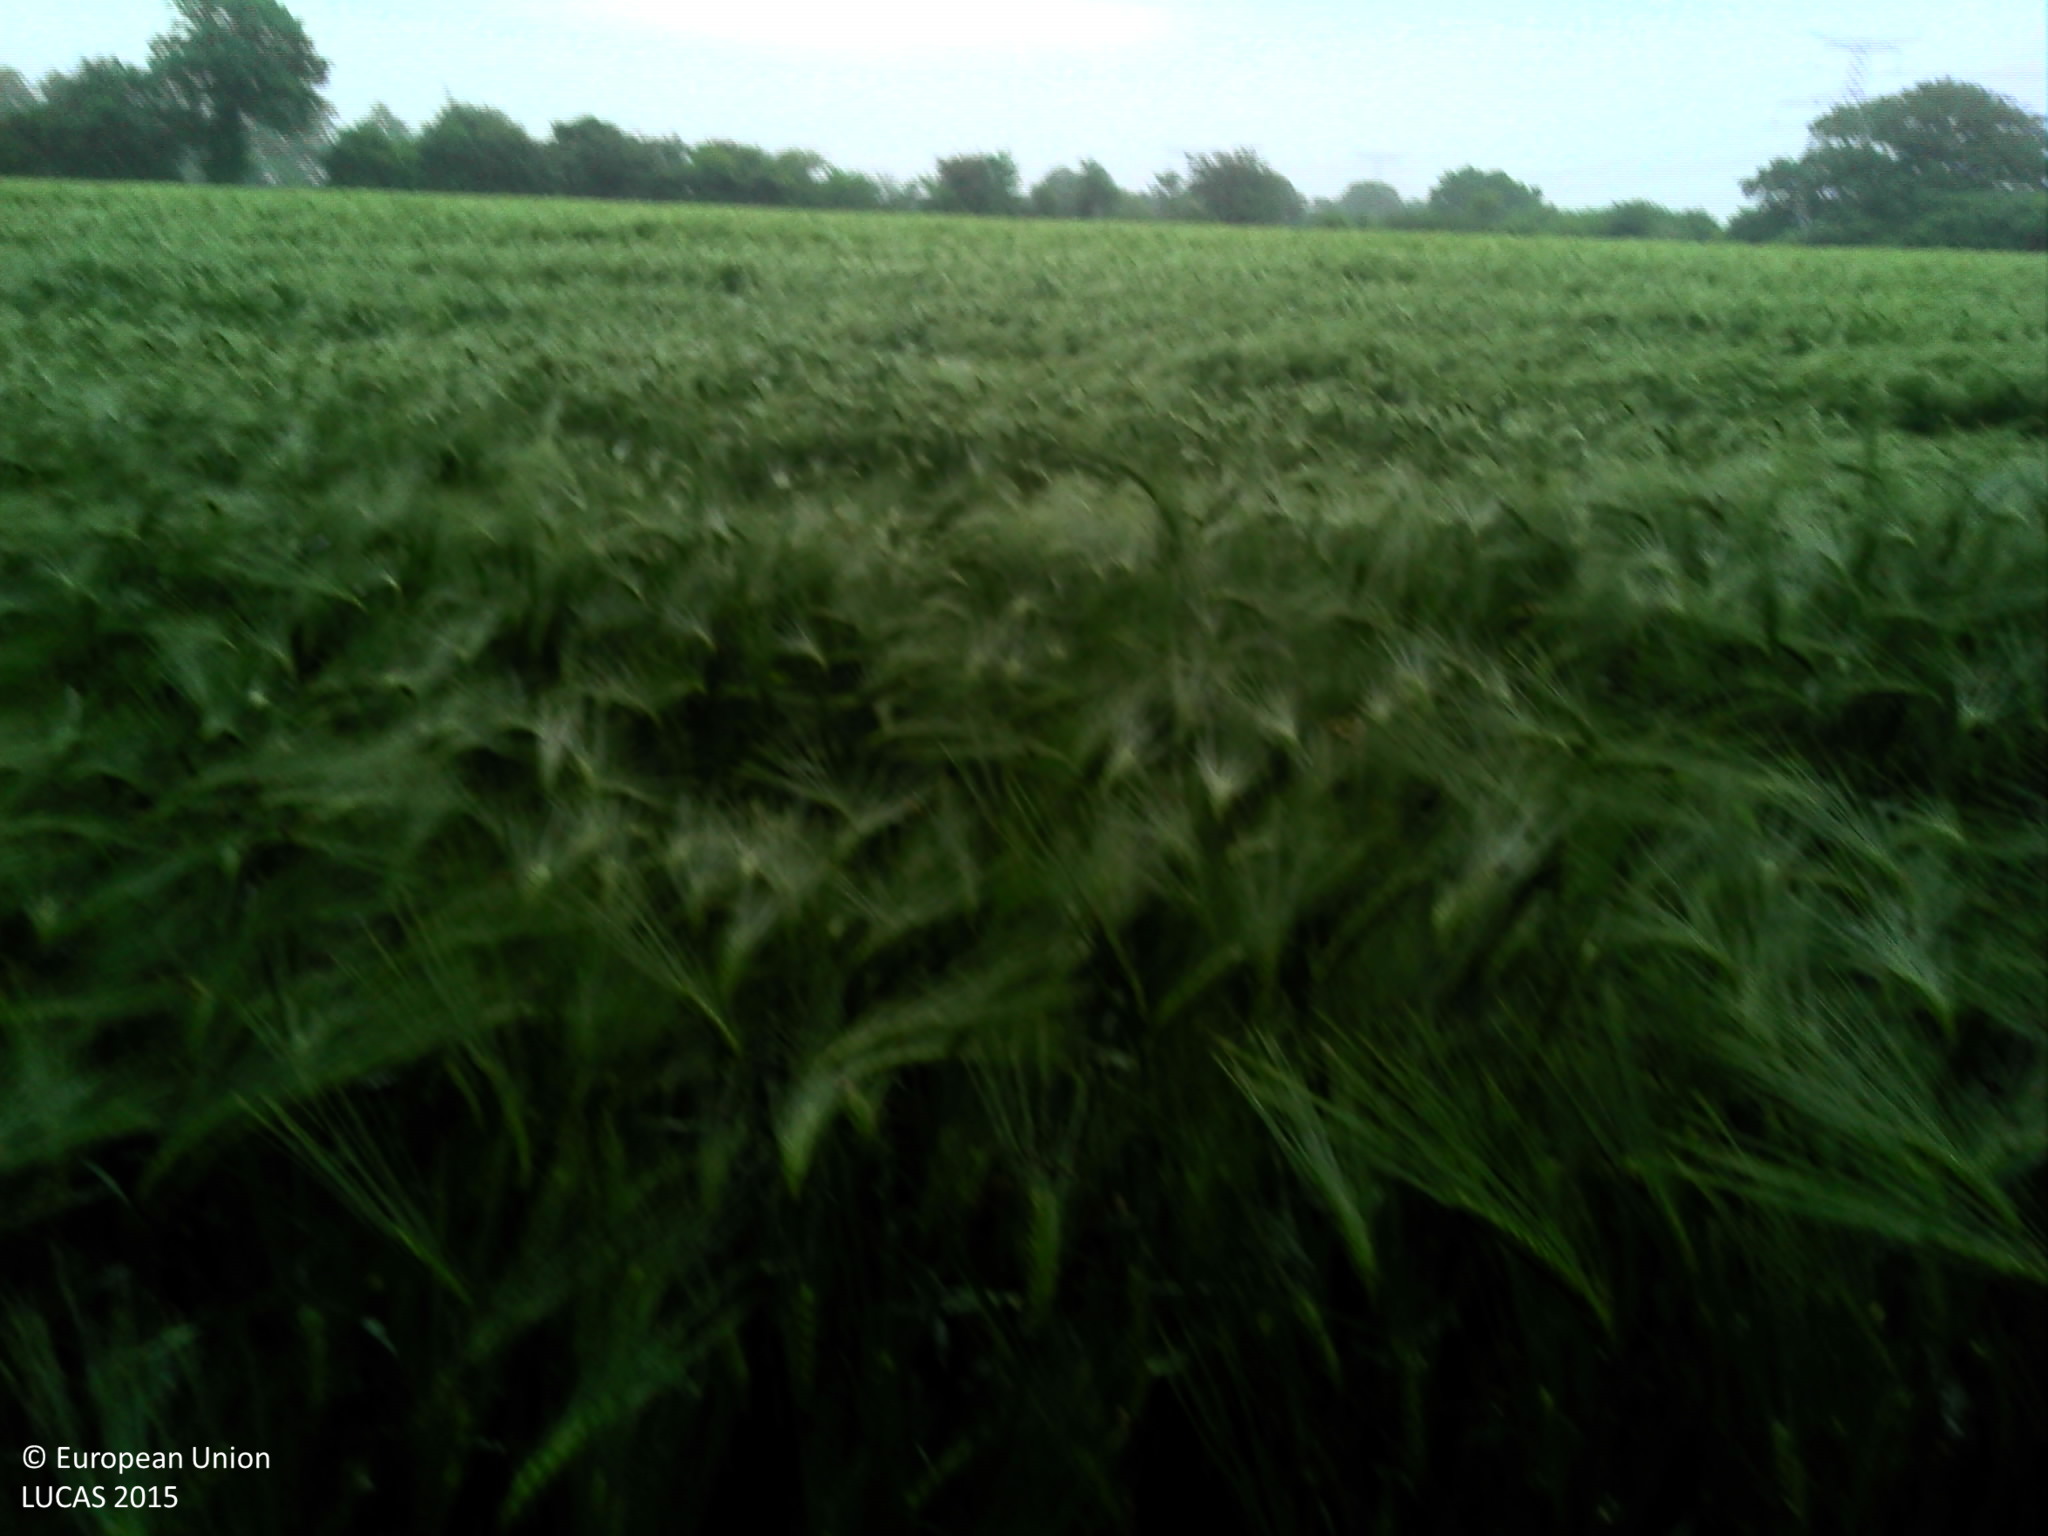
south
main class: Cropland
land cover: Barley
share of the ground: > 75 %
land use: Agriculture (excluding fallow land and kitchen gardens)
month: June
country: FR
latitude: 49.5251
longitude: -1.6983
